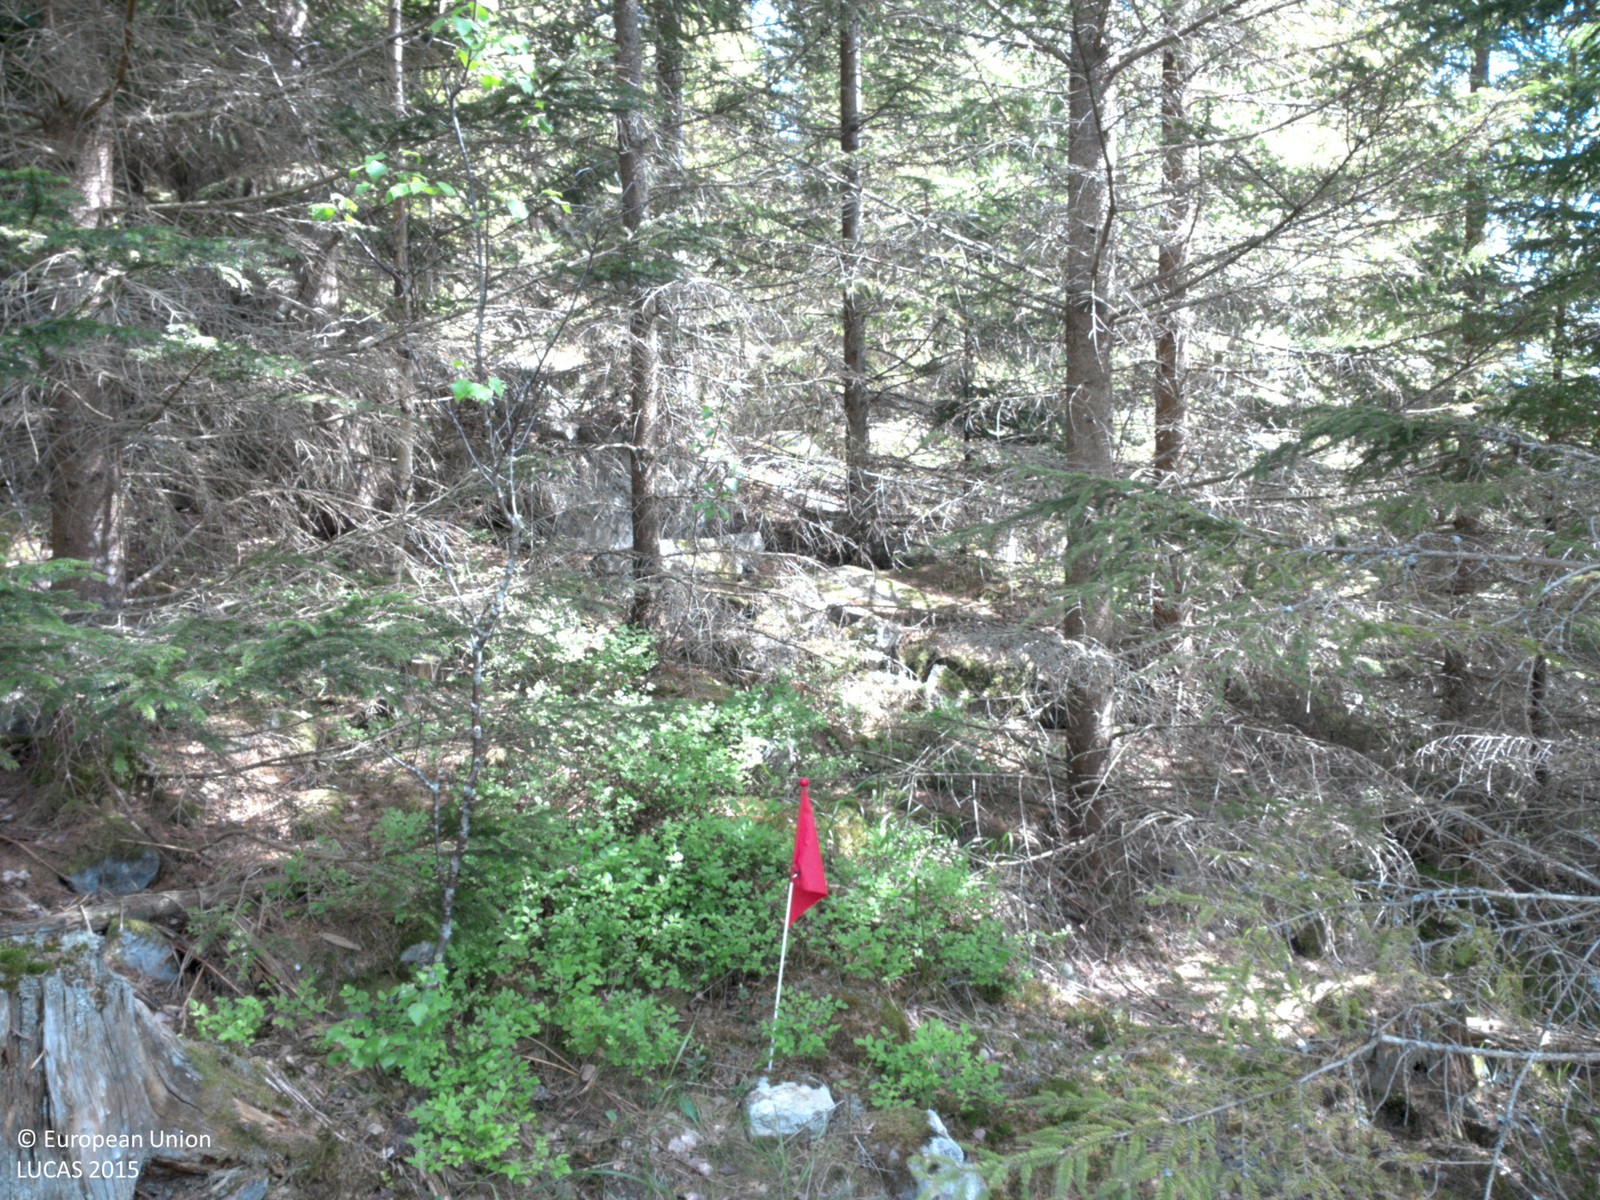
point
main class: Woodland
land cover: Spruce dominated mixed woodland
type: boreal forest
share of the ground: > 75 %
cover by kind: coniferous forest trees 55 %, broadleaved forest trees 25 %, lichens and mosses 15 %, shrubs 5 %
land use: Forestry
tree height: > 5 m
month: June
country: SE
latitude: 59.0802
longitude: 12.3848
